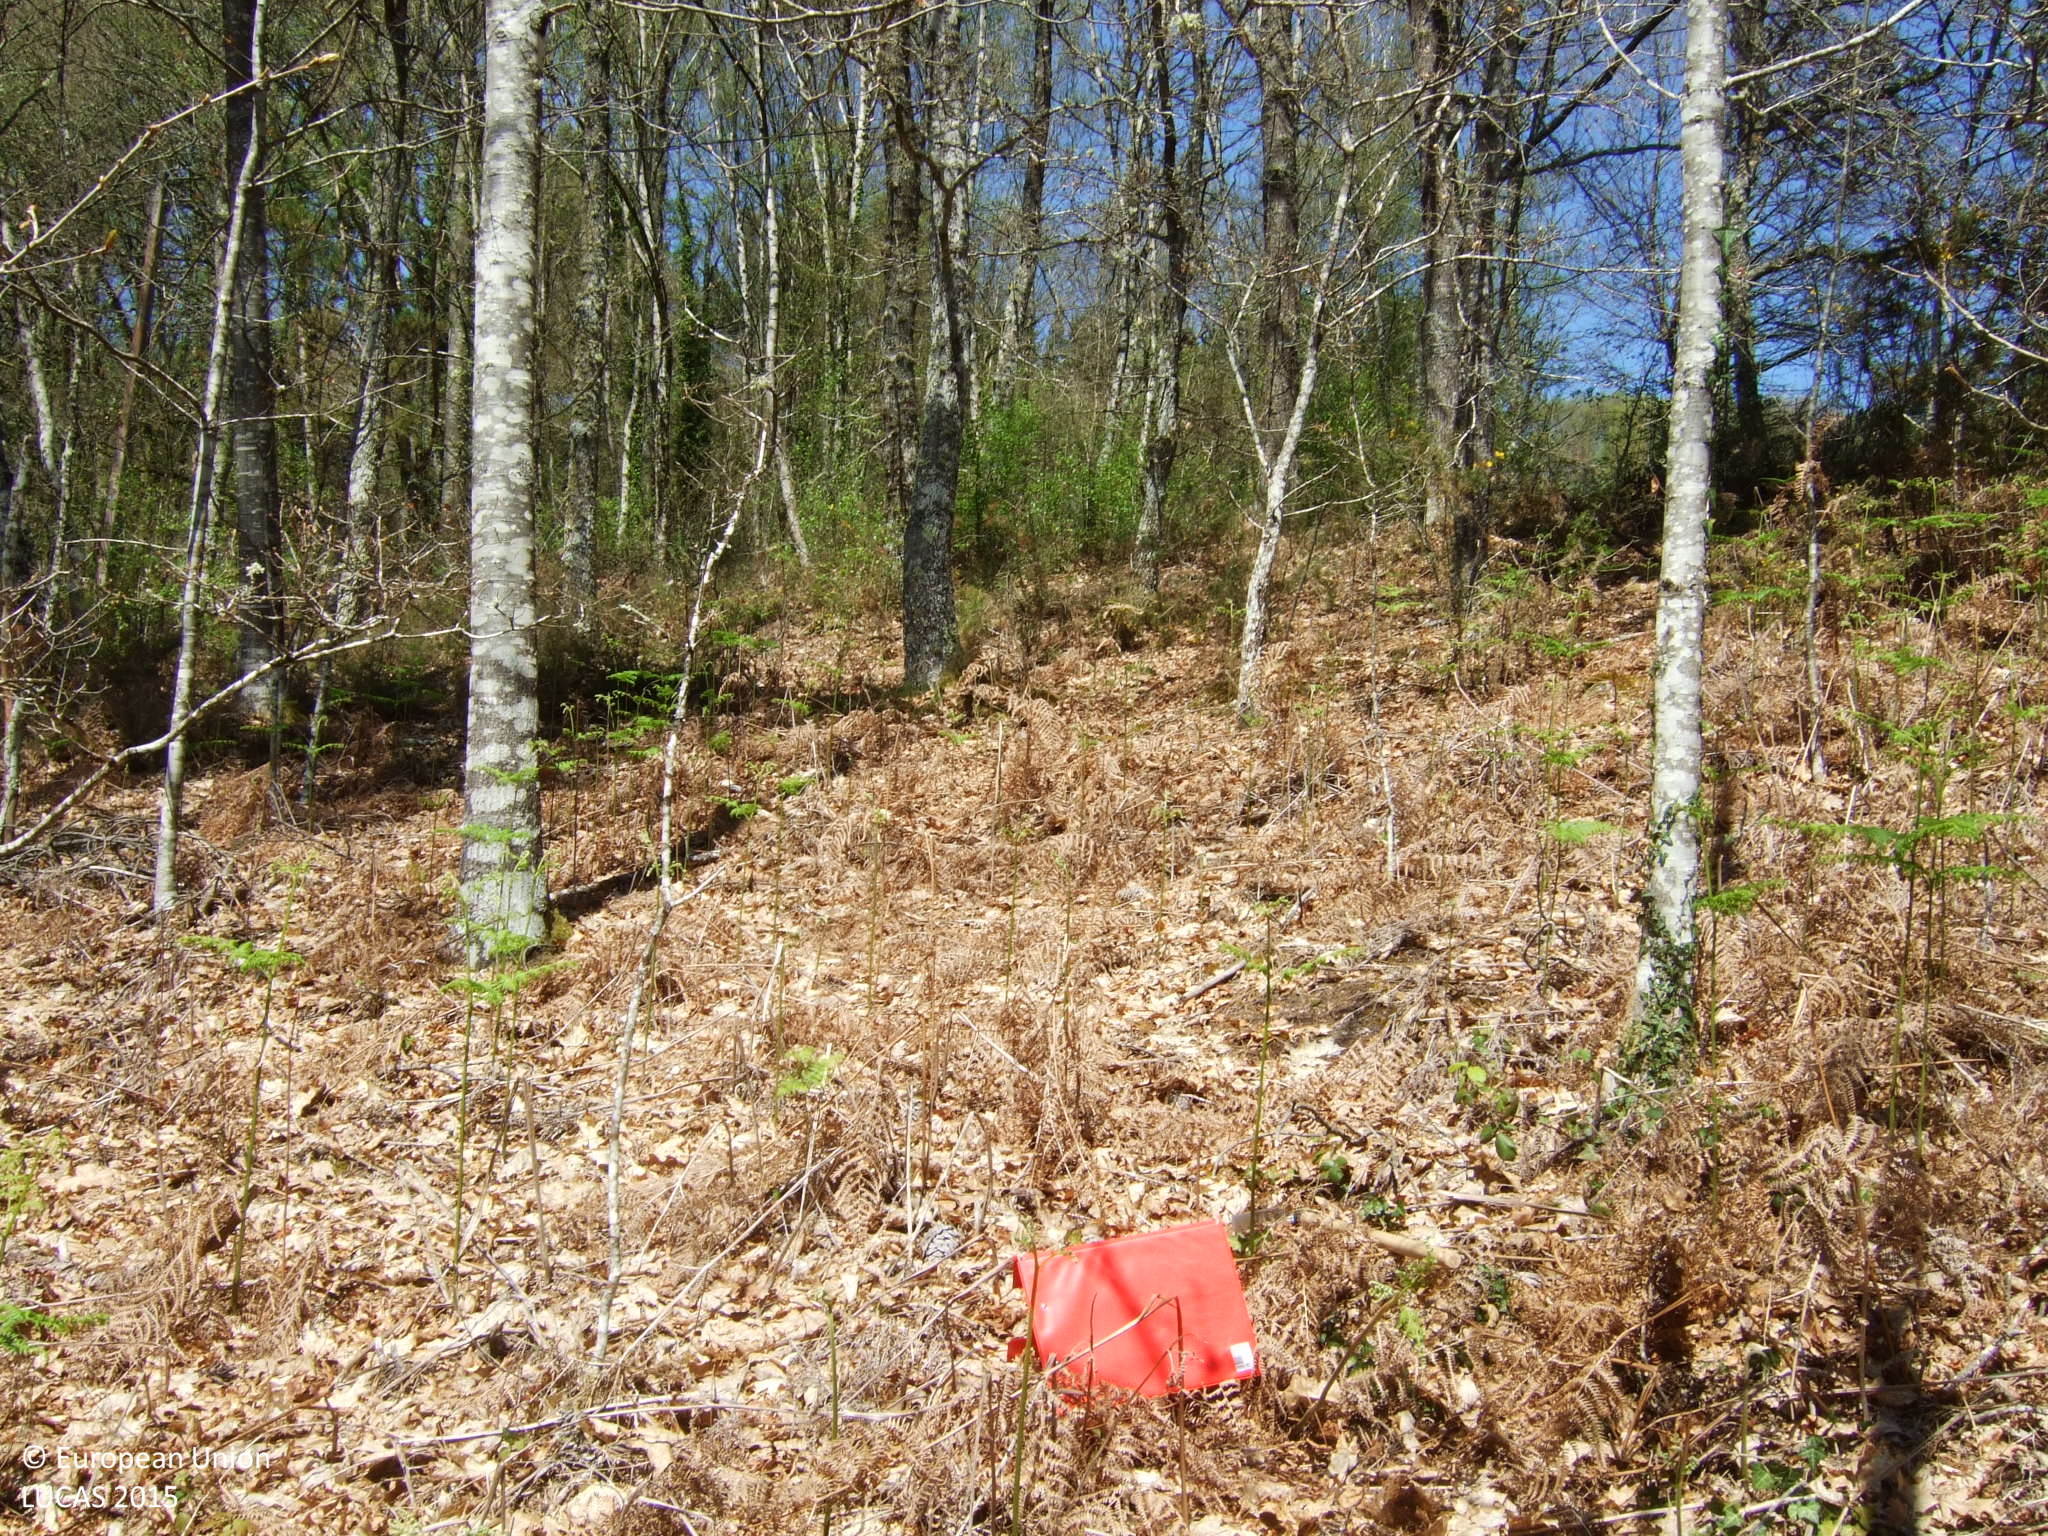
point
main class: Woodland
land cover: Broadleaved woodland
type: acidophilous oak and oak-birch forest
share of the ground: > 75 %
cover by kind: broadleaved forest trees 60 %, shrubs 30 %, unconsolidated bare surface 10 %
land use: Forestry
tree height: > 5 m
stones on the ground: < 10 %
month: April
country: ES
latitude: 42.9922
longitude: -7.6305
